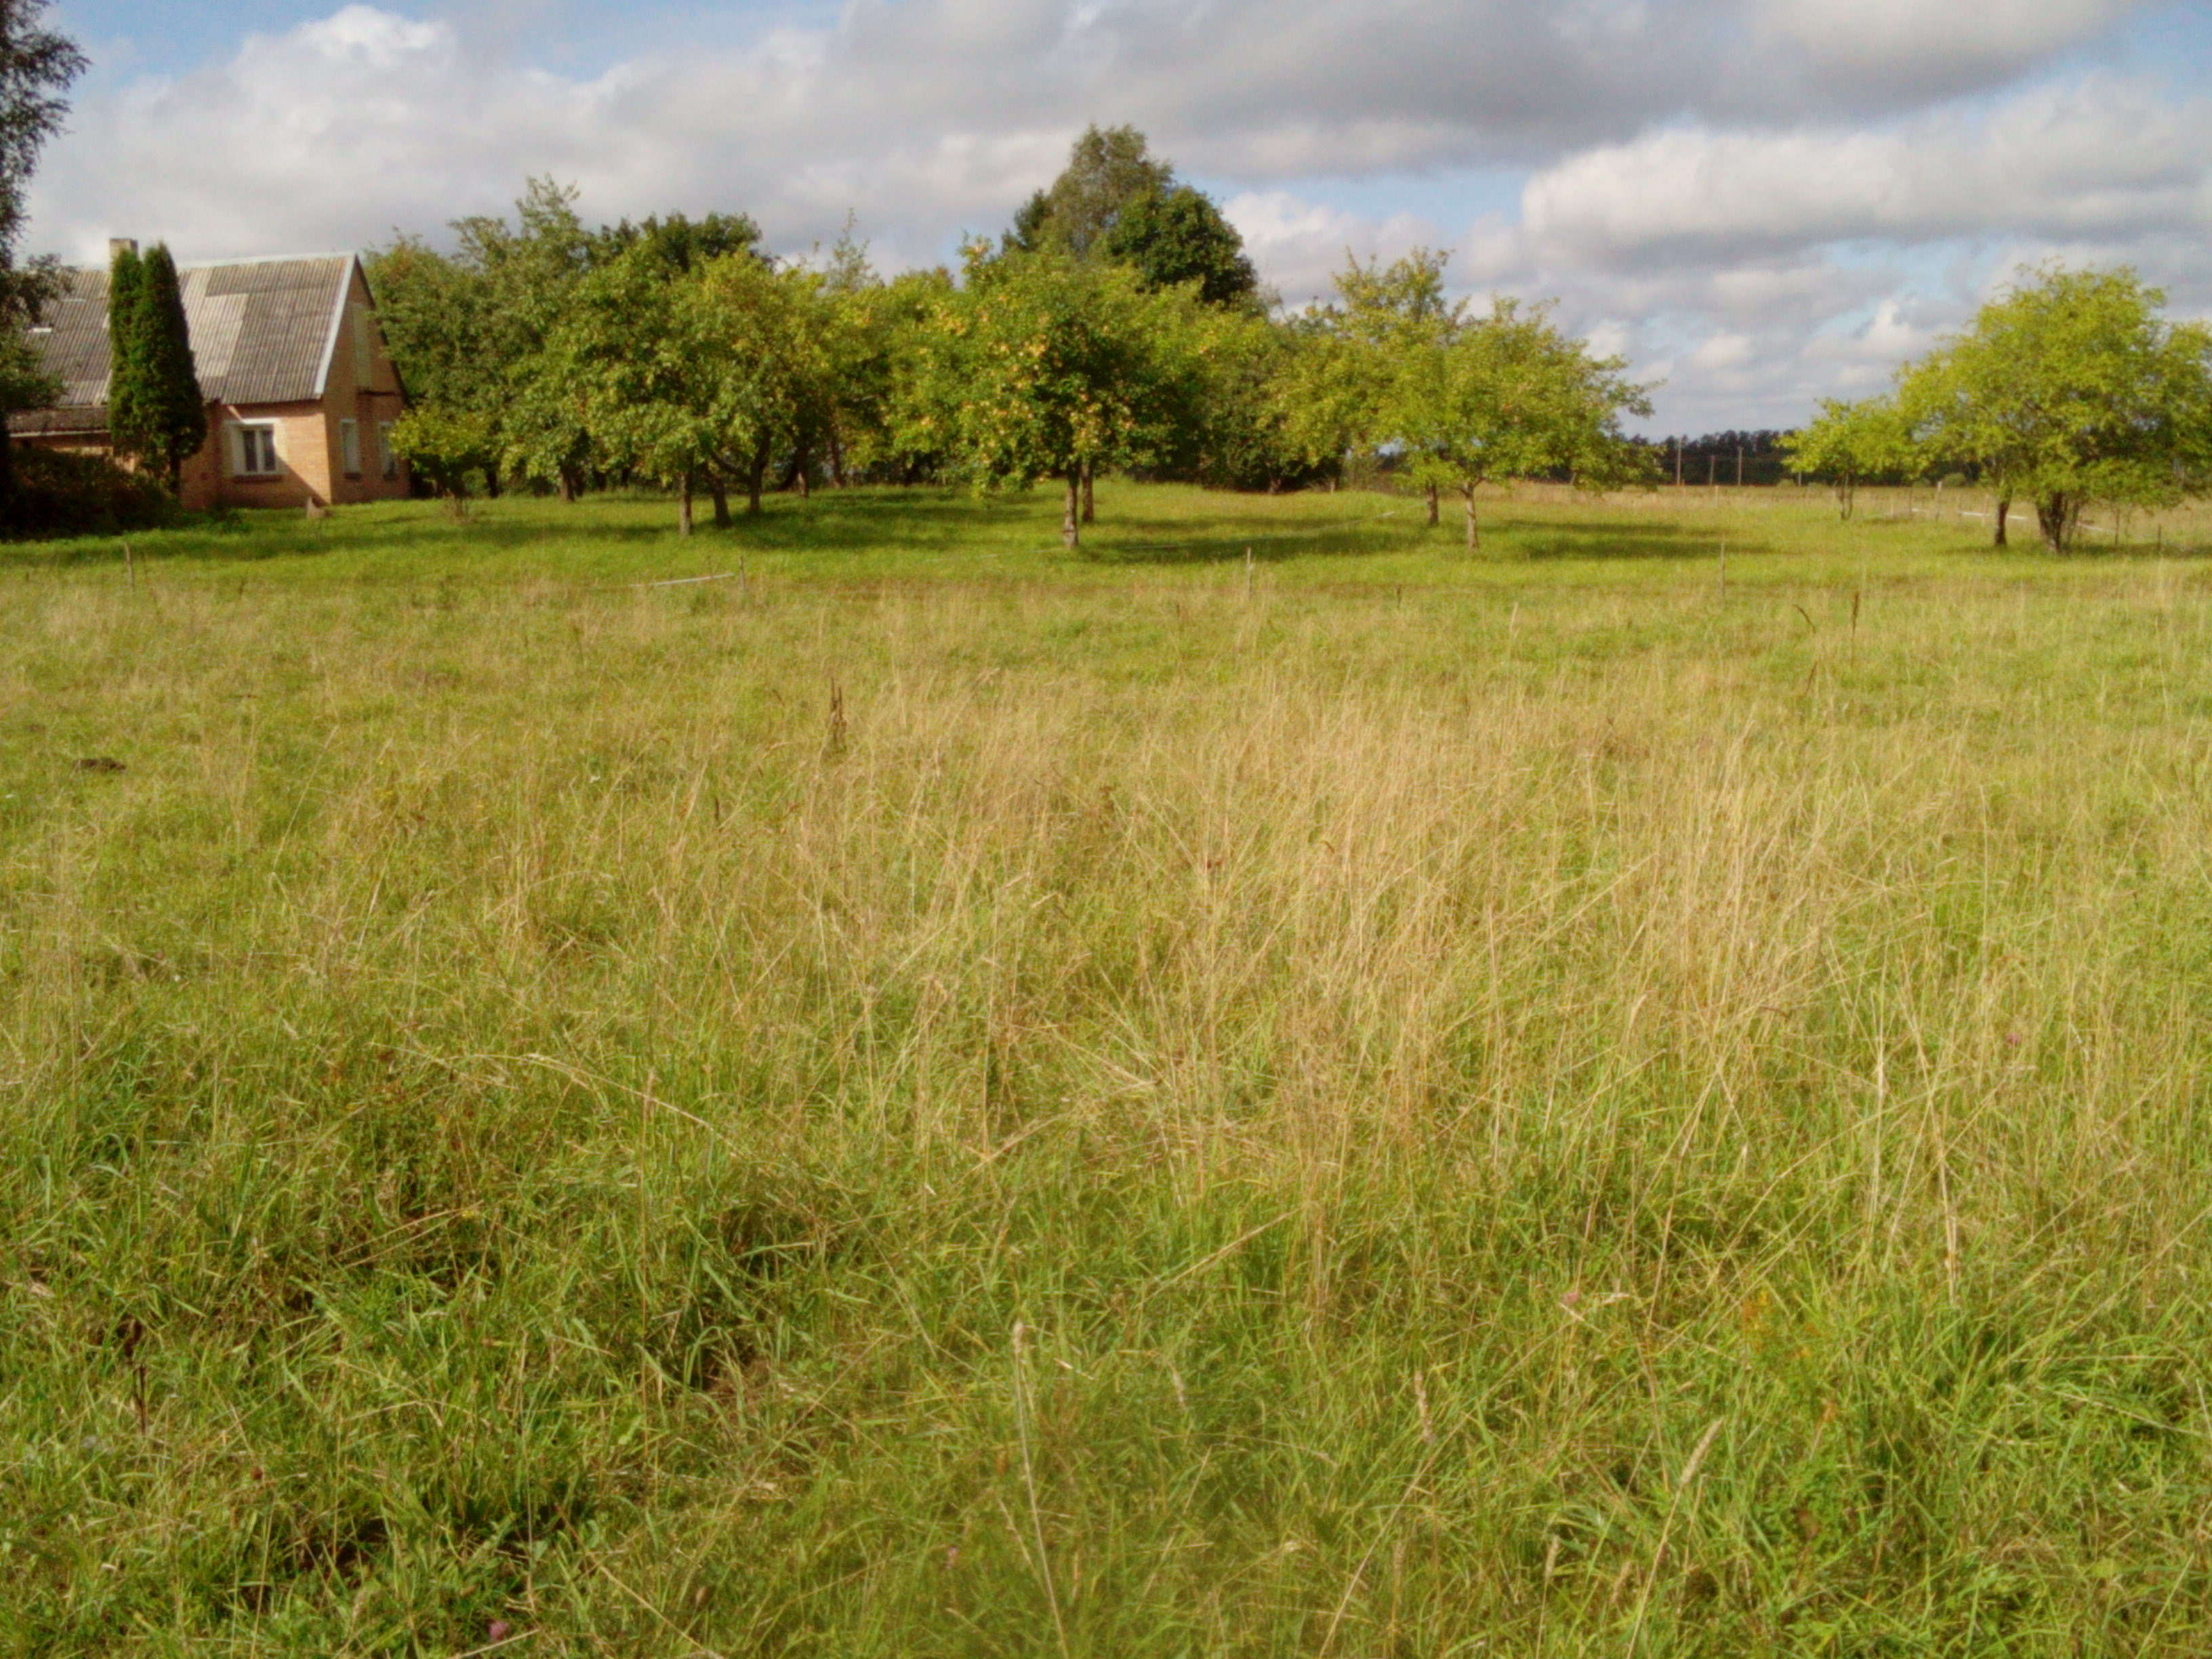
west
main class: Grassland
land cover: Grassland without tree/shrub cover
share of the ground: > 75 %
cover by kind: herbaceous plants 100 %
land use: Agriculture (excluding fallow land and kitchen gardens)
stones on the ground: < 10 %
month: September
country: LT
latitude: 55.9242
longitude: 22.8196
